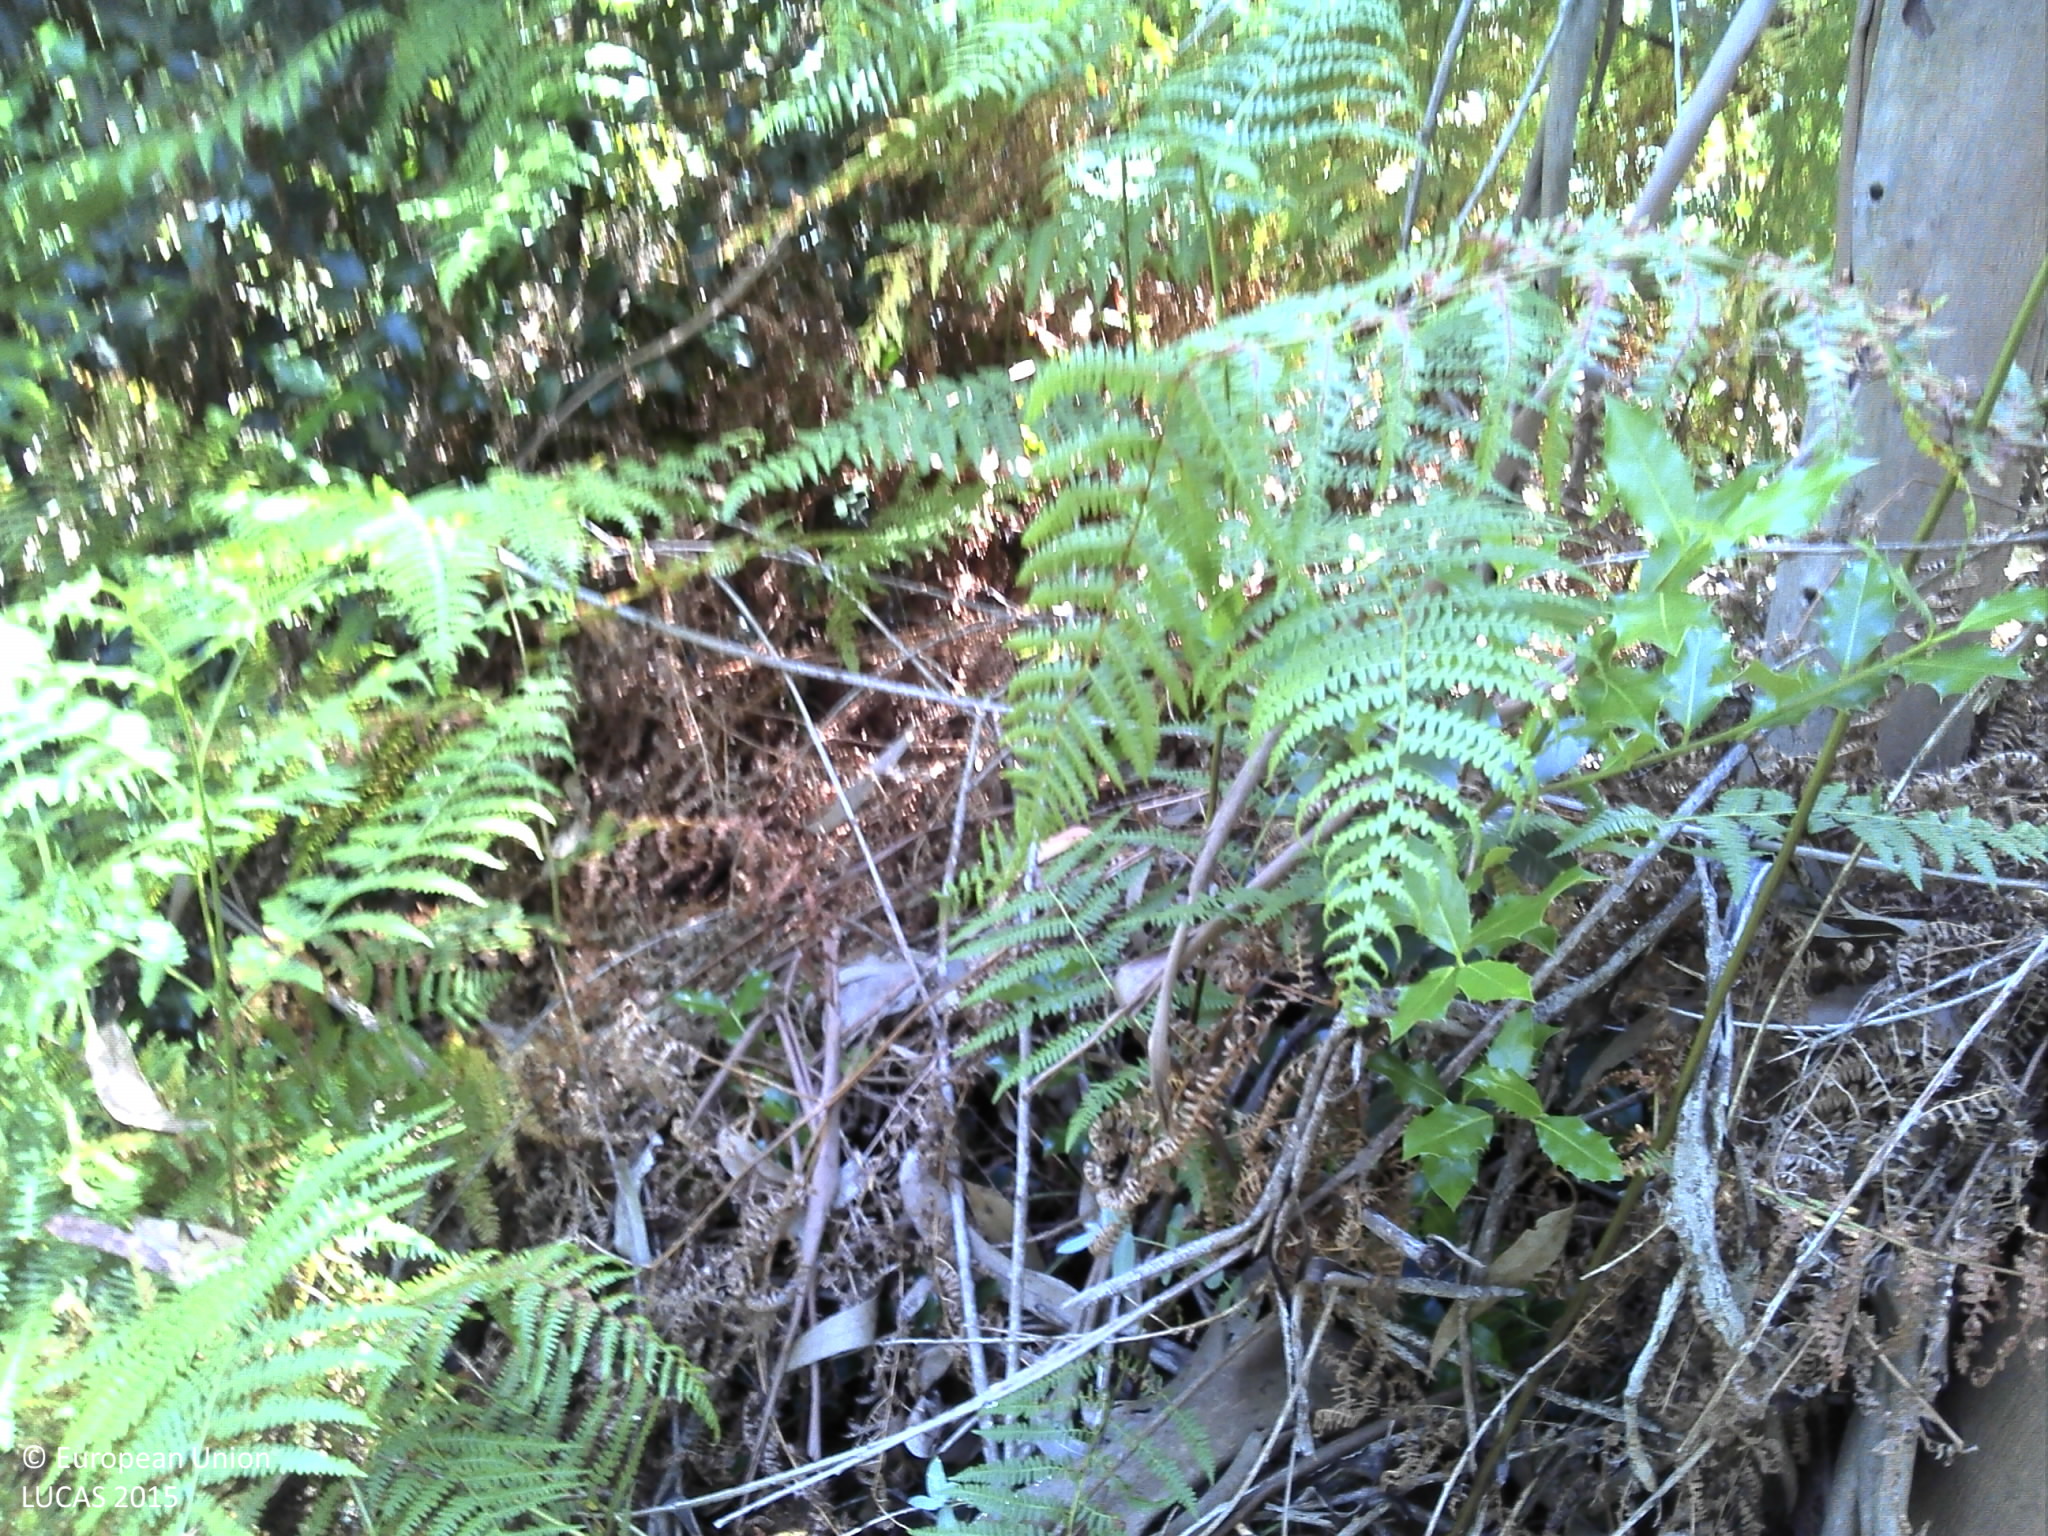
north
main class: Woodland
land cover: Broadleaved woodland
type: exotic forest
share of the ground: 50 - 75 %
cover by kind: broadleaved forest trees 60 %, shrubs 40 %
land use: Forestry
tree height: > 5 m
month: May
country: PT
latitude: 41.8284
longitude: -8.6473
